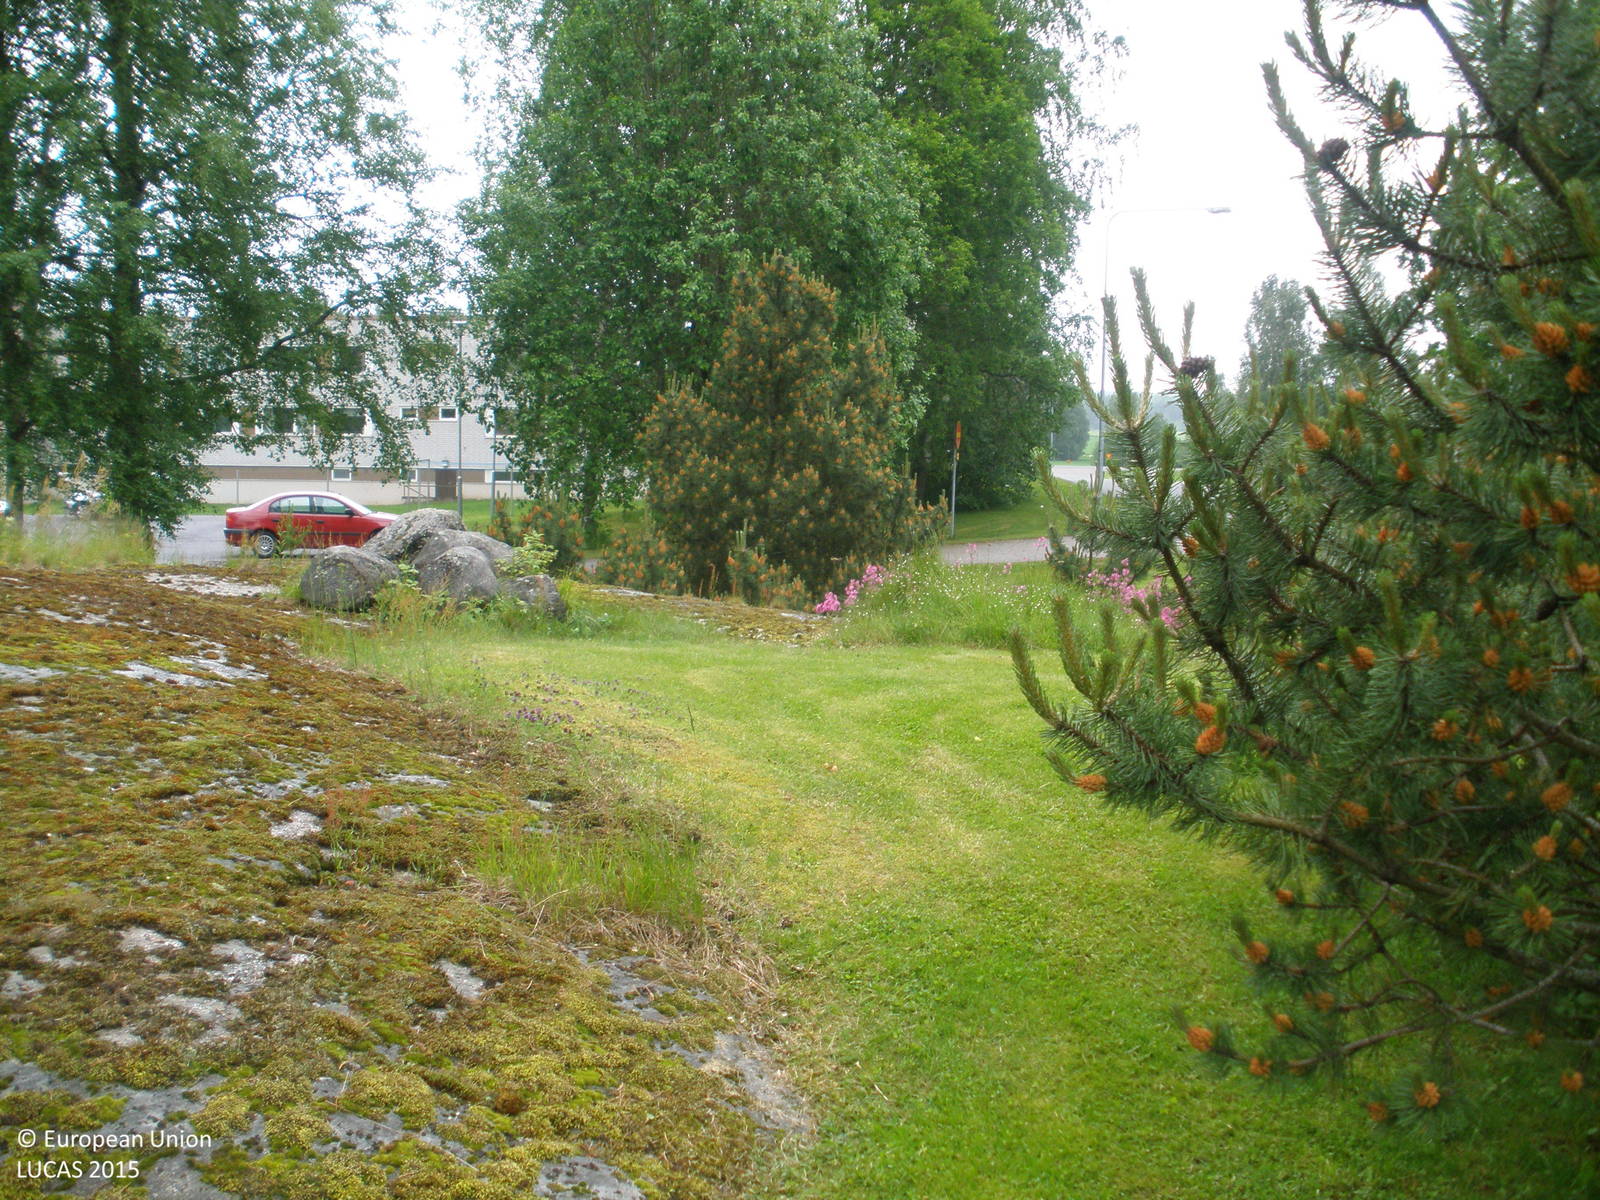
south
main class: Grassland
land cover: Grassland with sparse tree/shrub cover
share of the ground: > 75 %
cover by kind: herbaceous plants 95 %, coniferous forest trees 5 %
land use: Community services
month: June
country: FI
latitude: 61.0785
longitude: 23.5597
